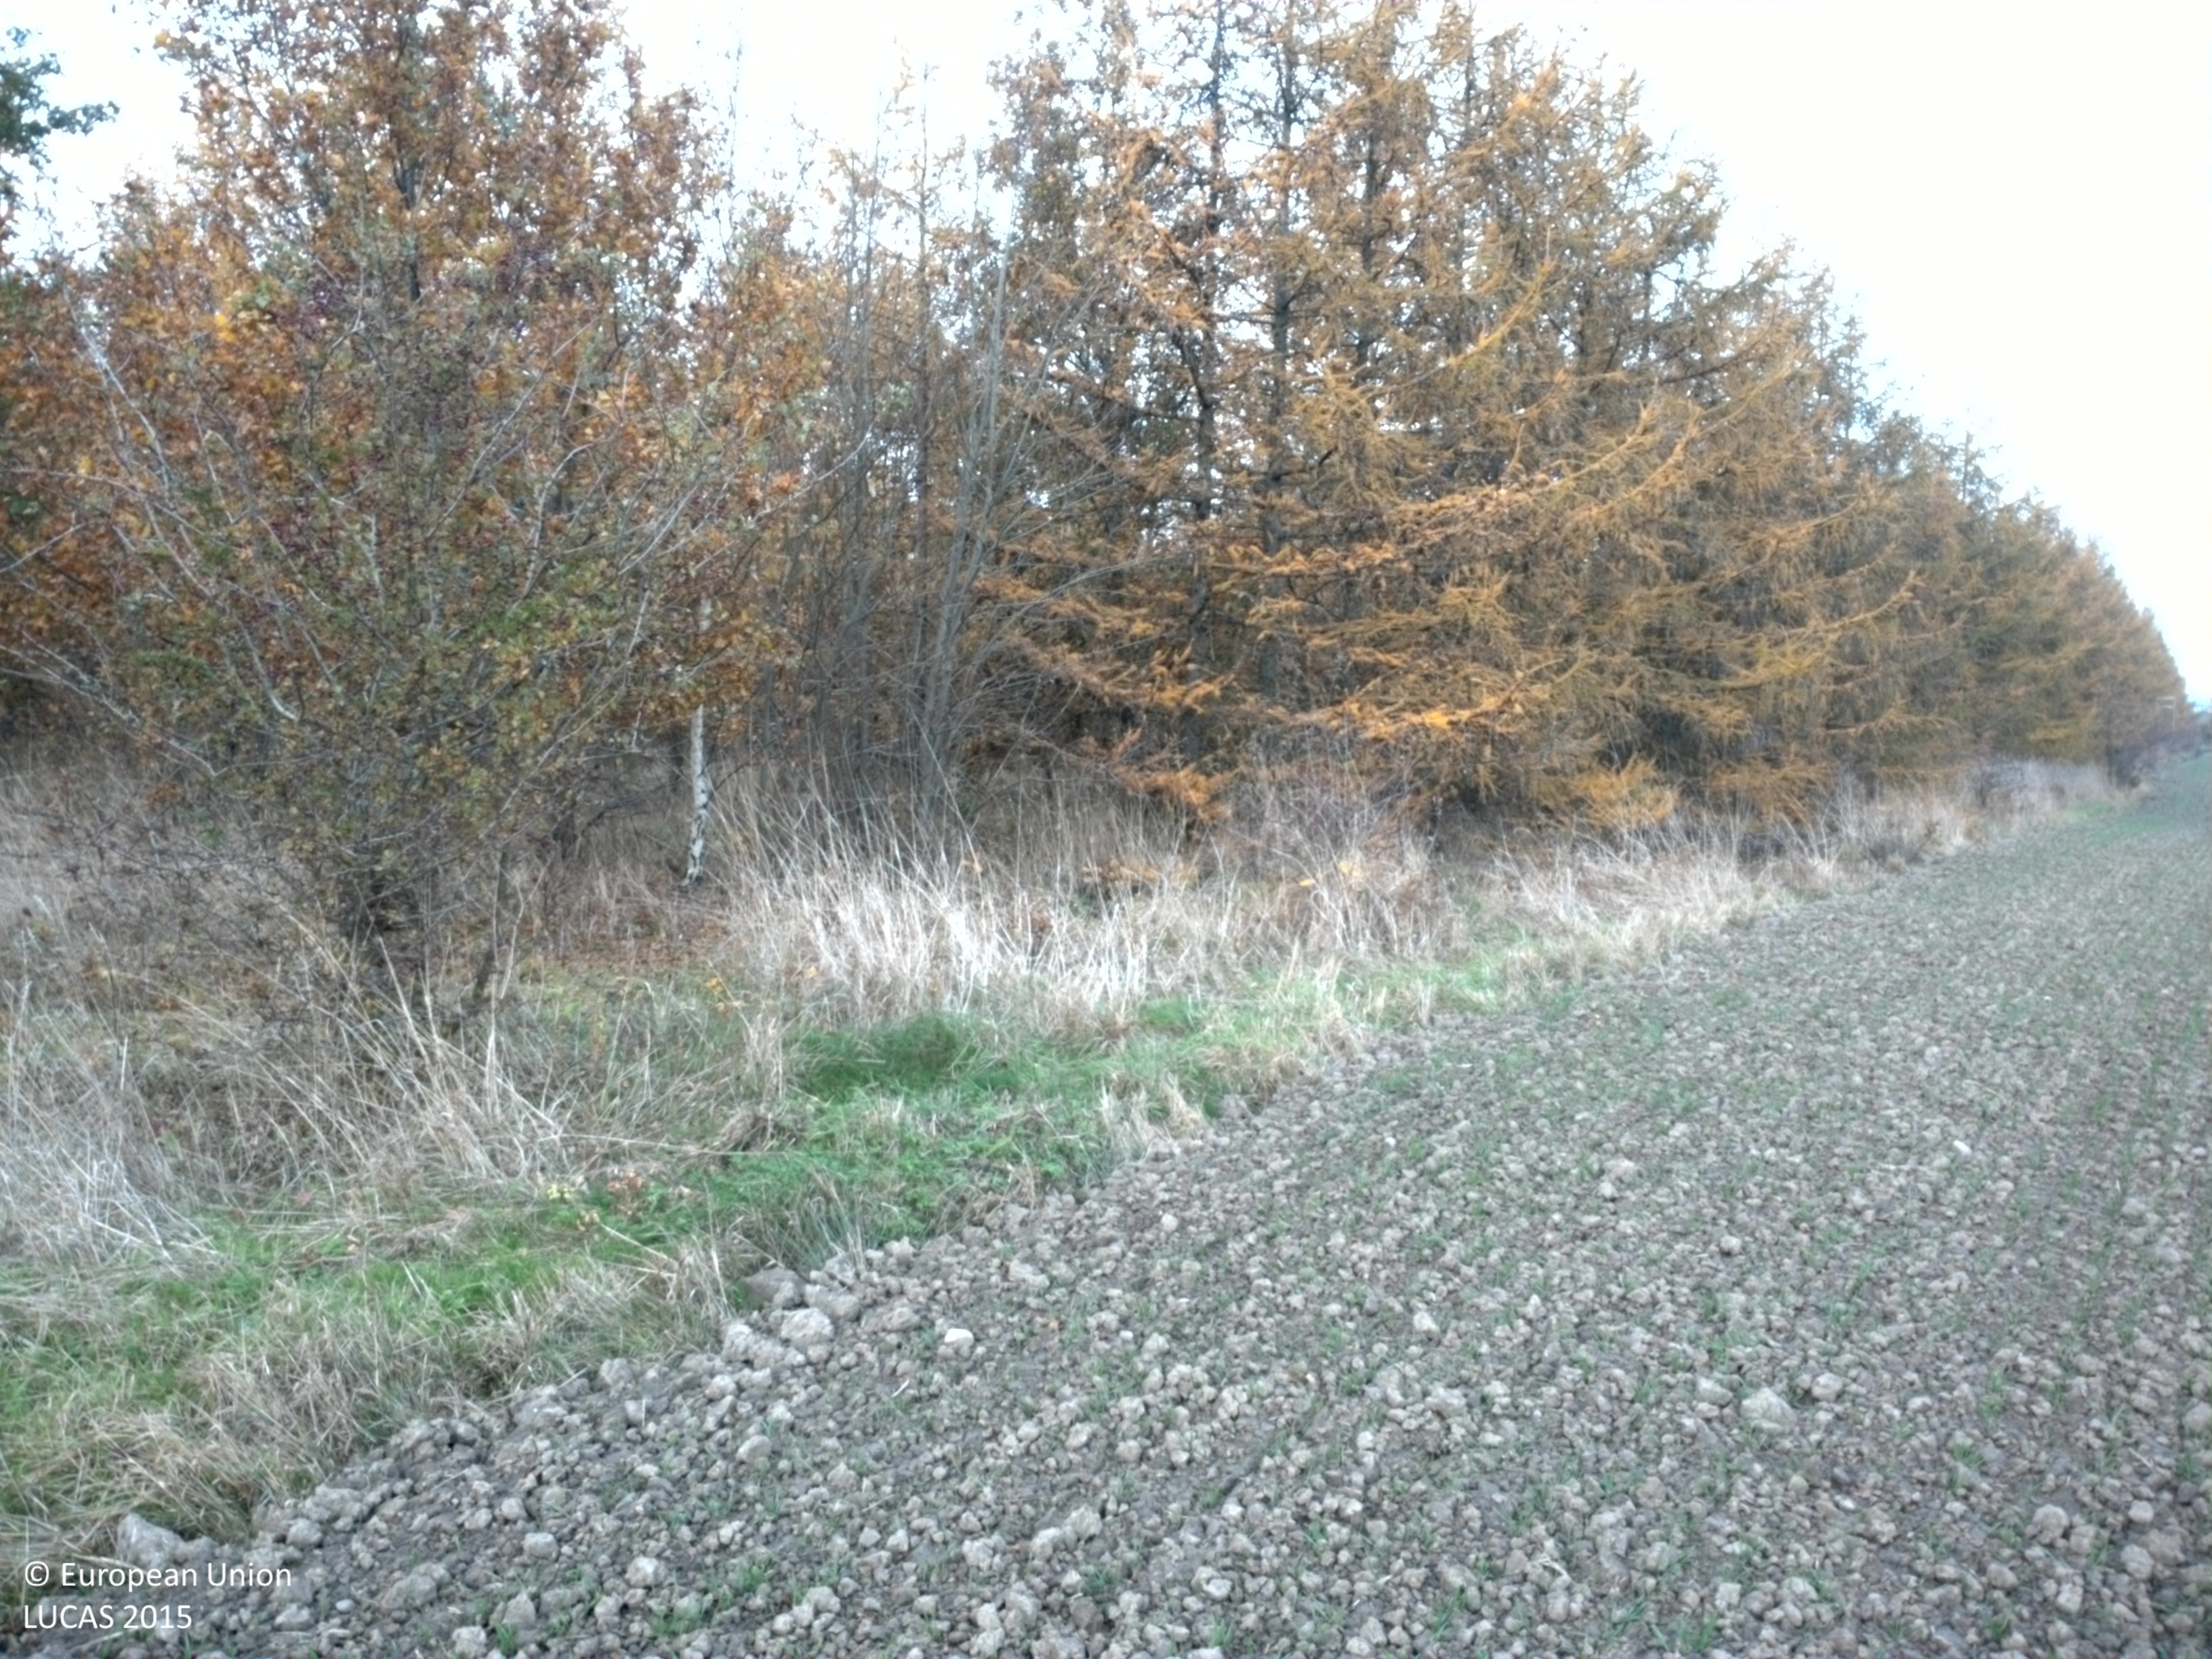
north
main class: Cropland
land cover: Common wheat
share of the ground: < 10 %
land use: Agriculture (excluding fallow land and kitchen gardens)
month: November
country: SE
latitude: 56.1323
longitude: 13.1028
